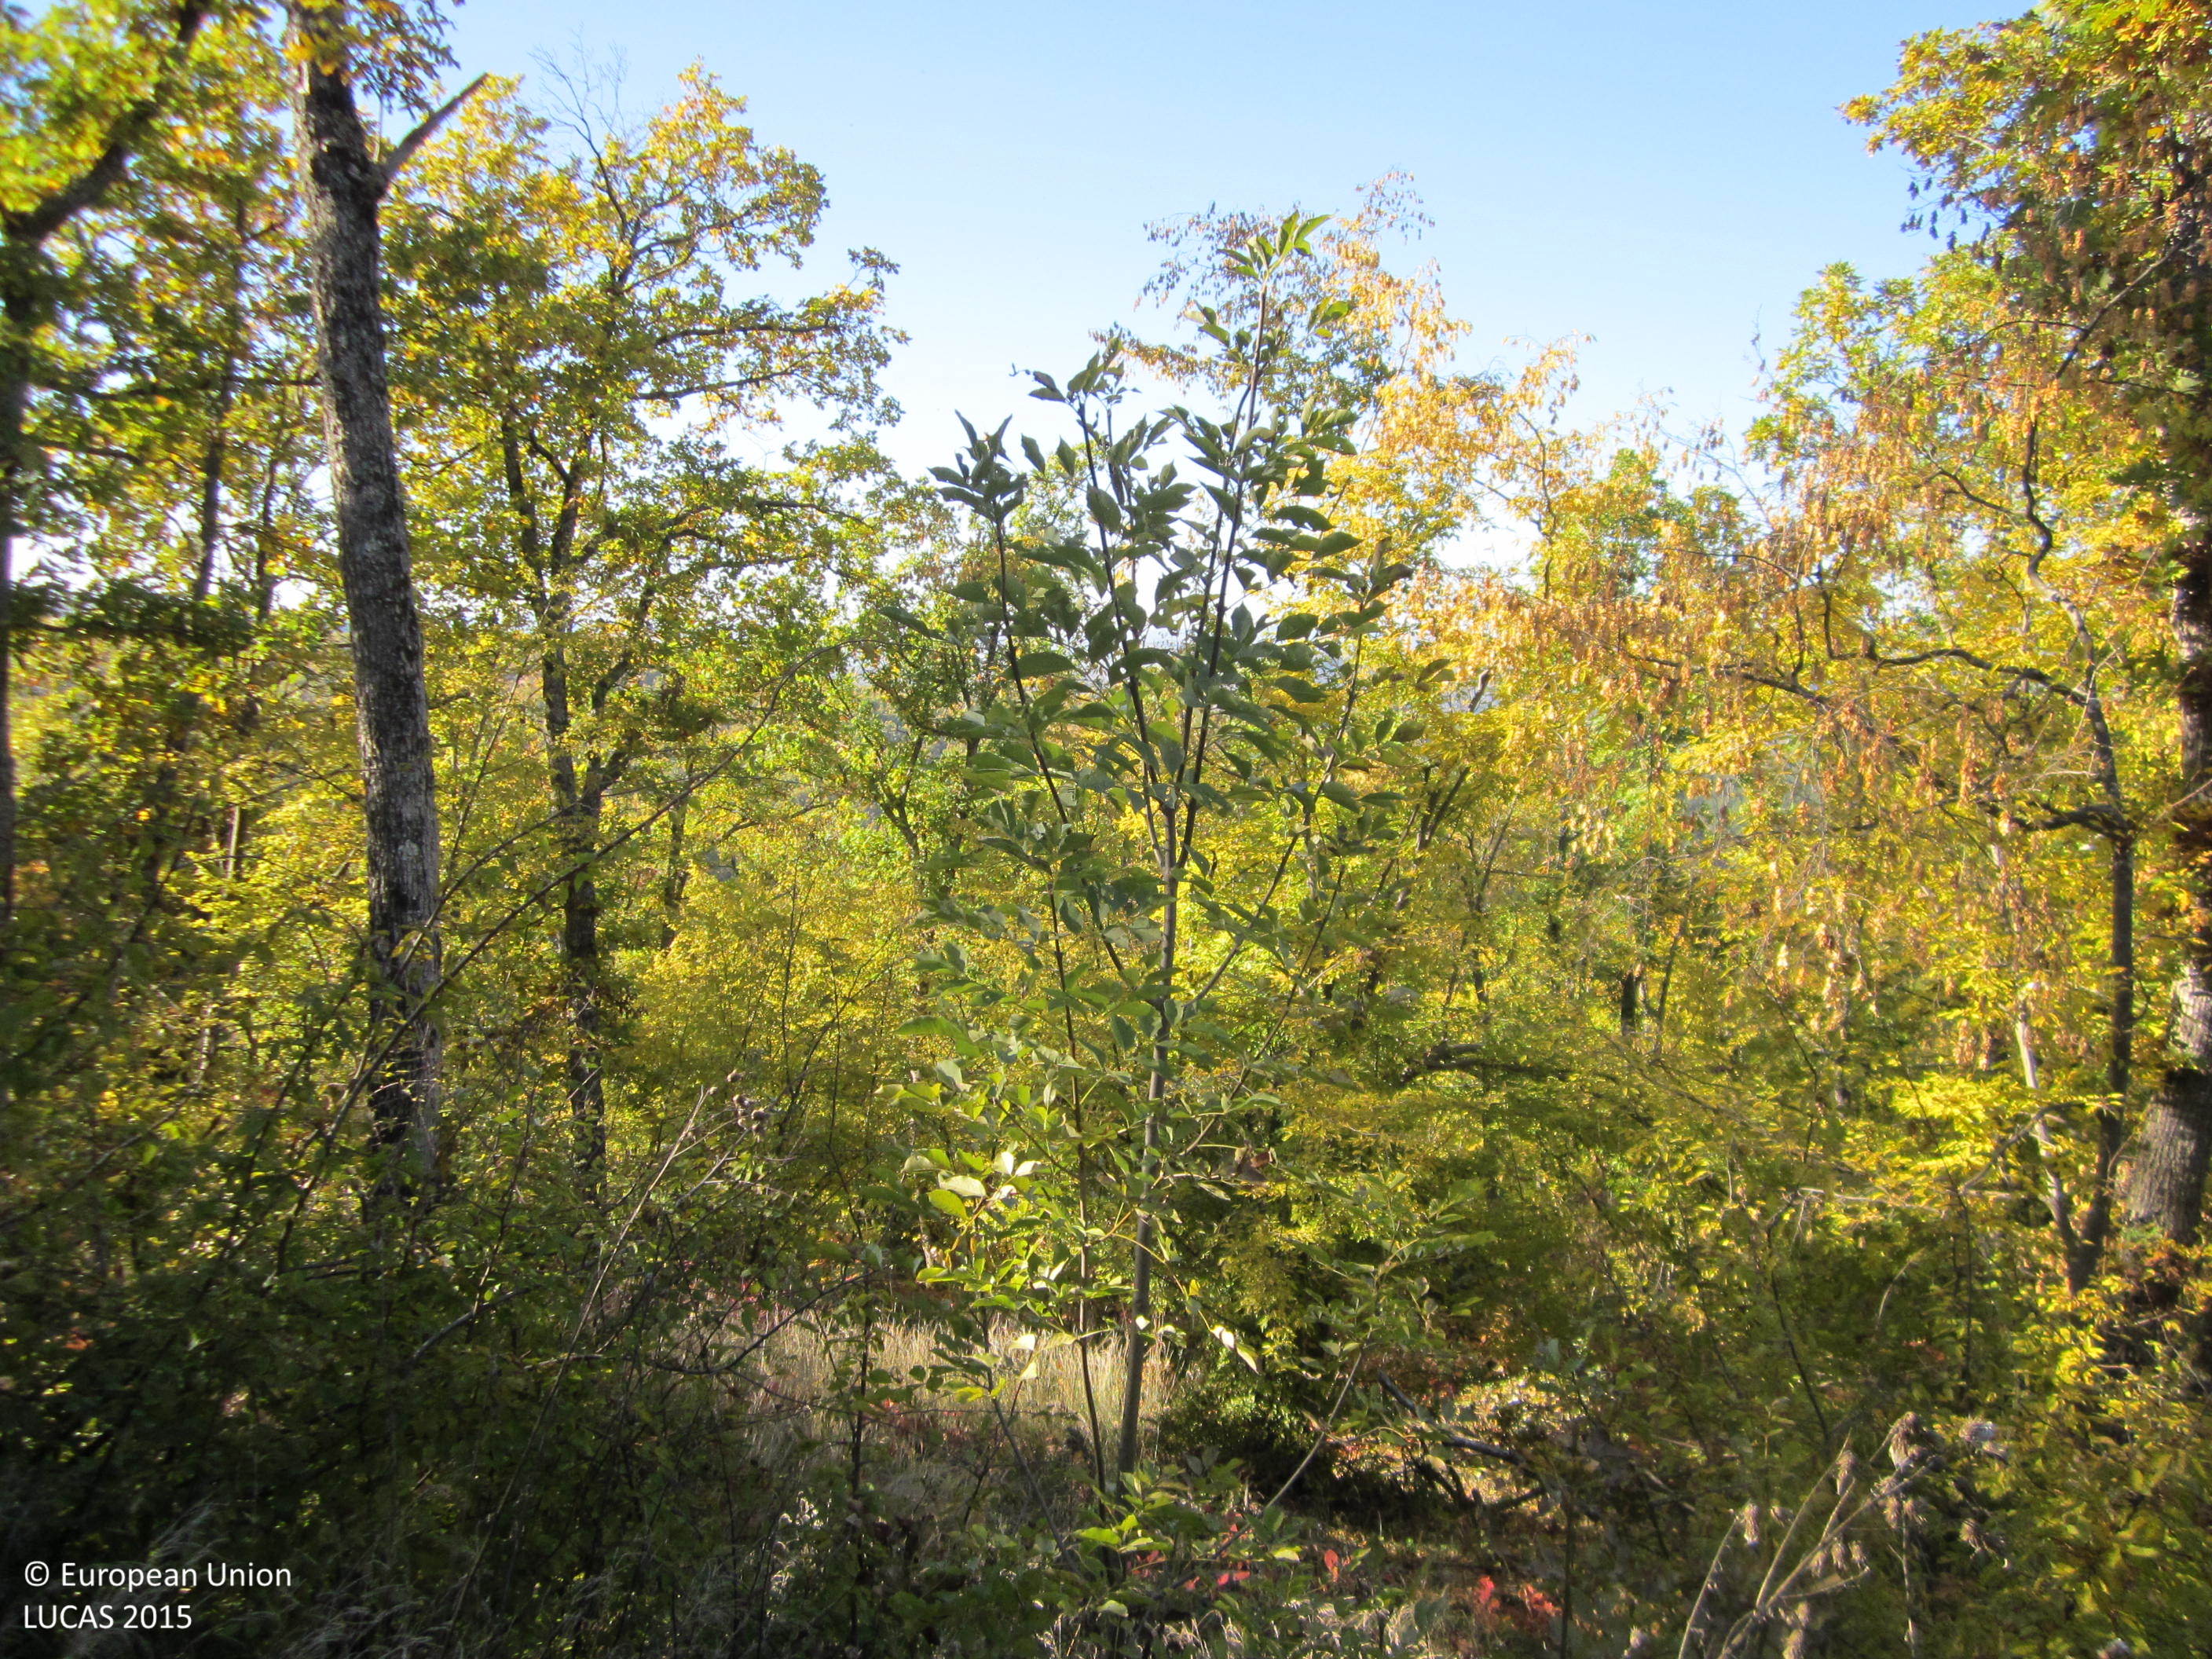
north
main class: Woodland
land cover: Broadleaved woodland
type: mesophytic deciduous forest
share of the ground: > 75 %
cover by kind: broadleaved forest trees 80 %, shrubs 10 %, herbaceous plants 10 %
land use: Forestry
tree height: > 5 m
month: November
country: BG
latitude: 41.6112
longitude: 25.7725
